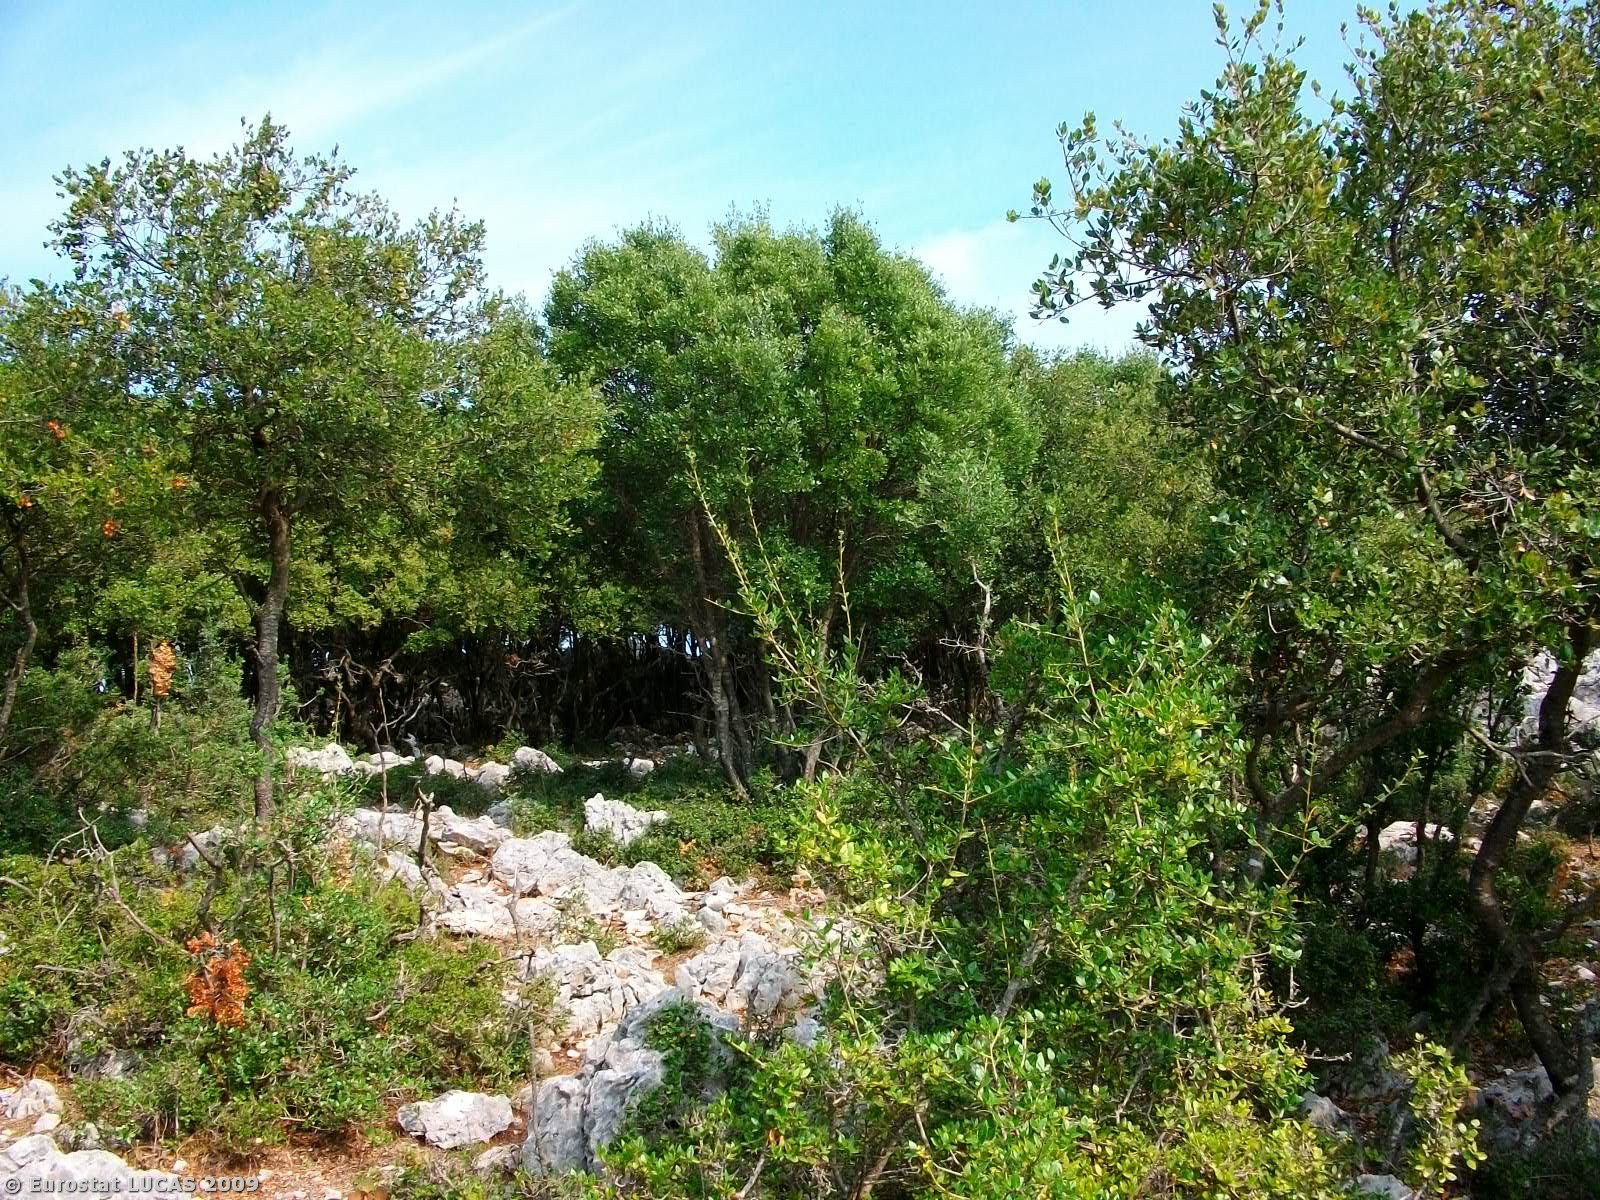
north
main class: Shrubland
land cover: Shrubland with sparse tree cover
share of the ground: 50 - 75 %
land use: Agriculture (excluding fallow land and kitchen gardens)
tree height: < 5 m
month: October
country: GR
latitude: 39.3584
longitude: 20.4762
